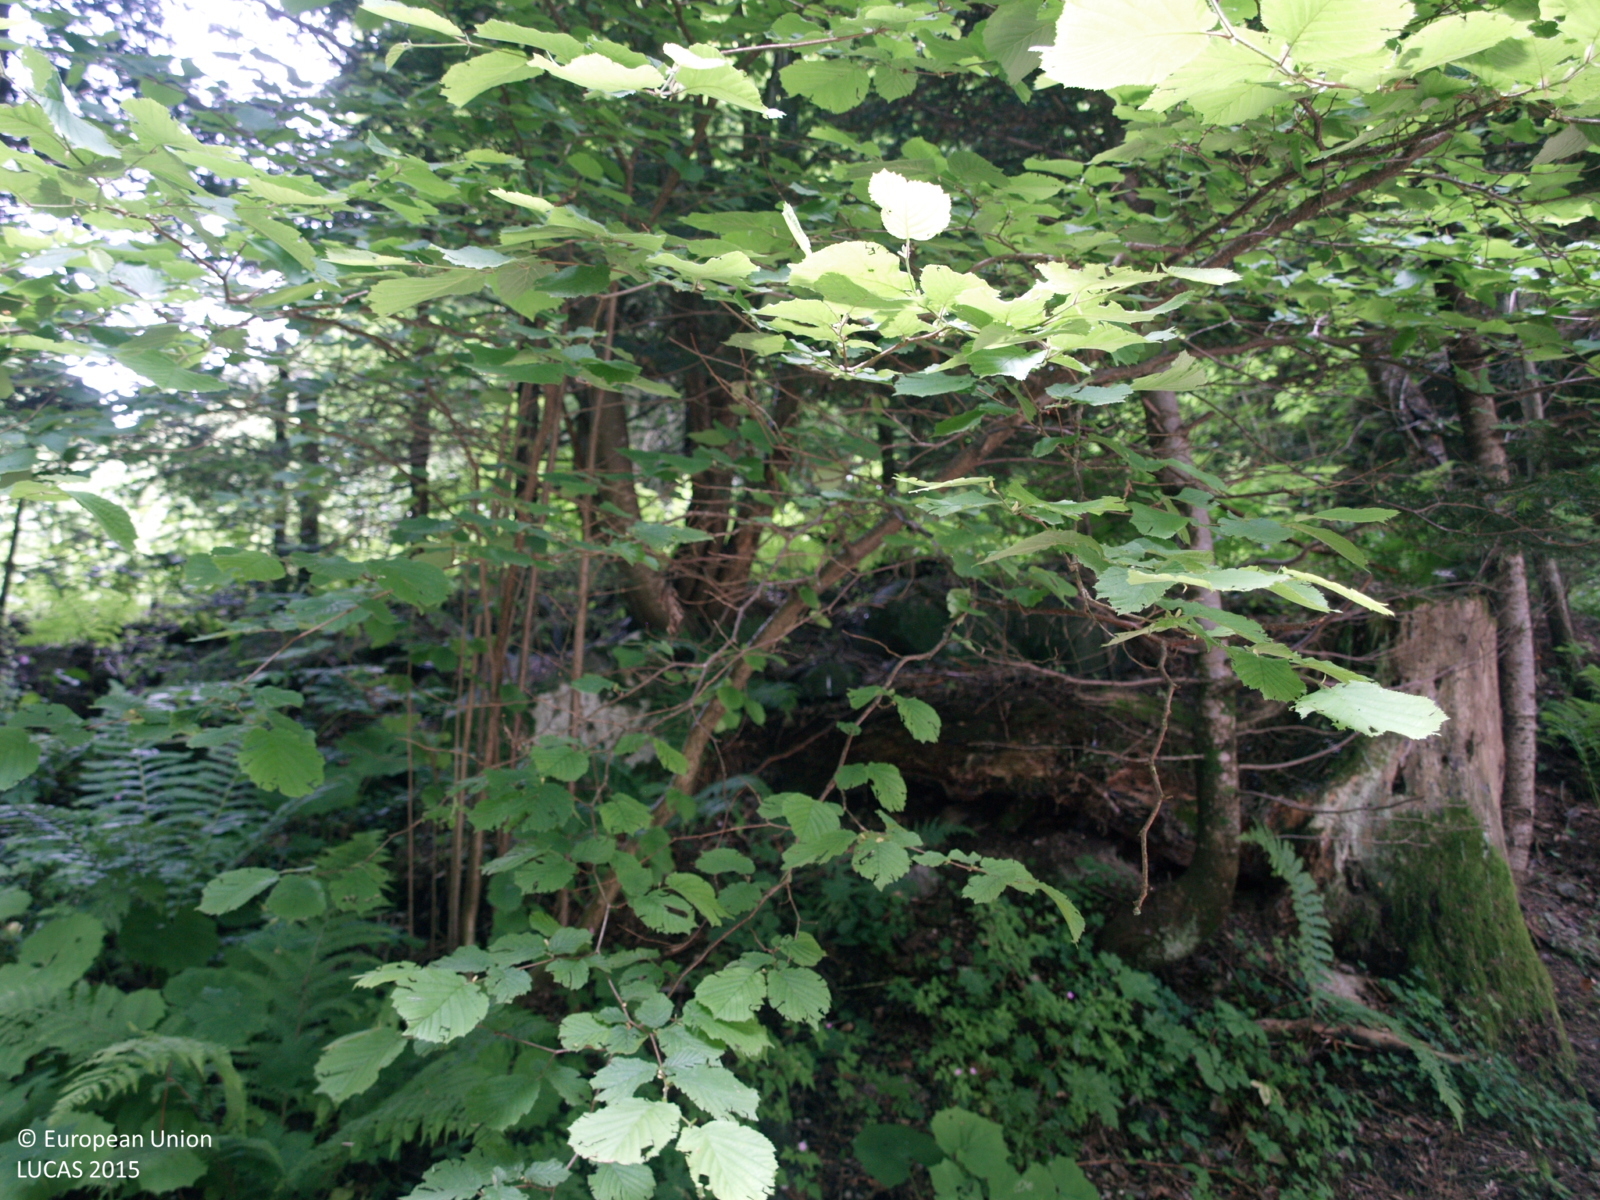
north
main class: Woodland
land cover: Spruce dominated coniferous woodland
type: alpine coniferous forest
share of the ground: > 75 %
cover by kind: coniferous forest trees 100 %
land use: Forestry
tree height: > 5 m
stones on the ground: 10 - 25 %
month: May
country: IT
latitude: 46.1486
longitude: 10.9697
